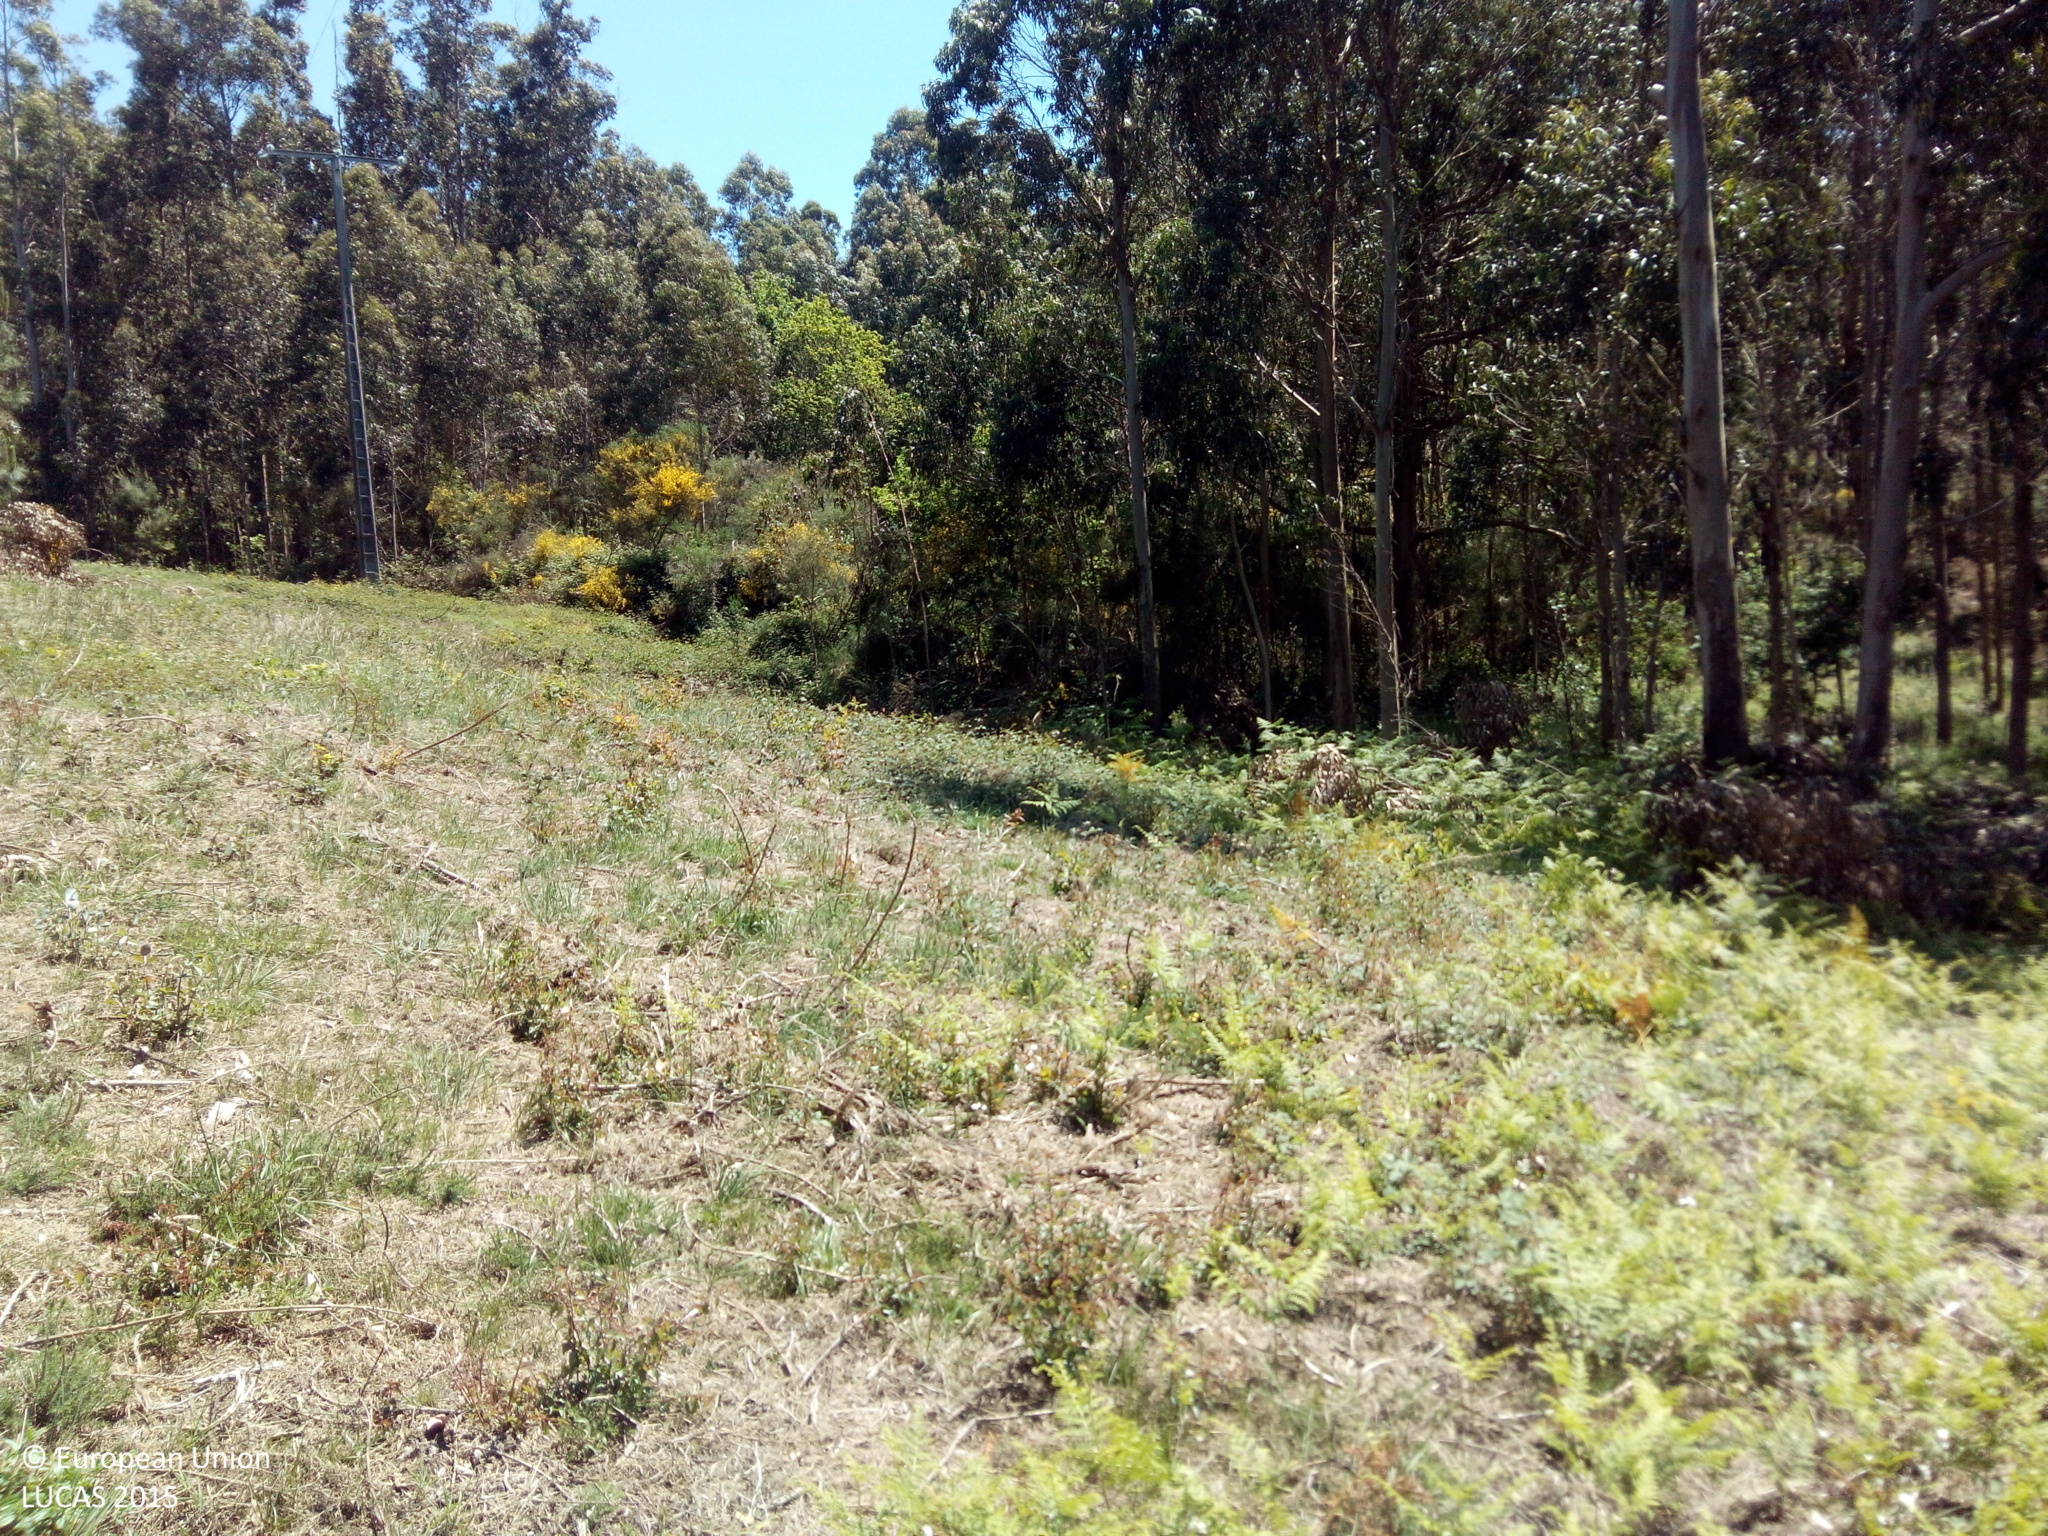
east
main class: Shrubland
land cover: Shrubland with sparse tree cover
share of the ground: > 75 %
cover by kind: shrubs 95 %, coniferous forest trees 5 %
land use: Forestry
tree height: > 5 m
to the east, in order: Shrubland with sparse tree cover; Electric lines; Broadleaved woodland; Artificial constructions; Pine dominated mixed woodland; Tracks; Pine dominated mixed woodland; Artificial constructions; Pine dominated mixed woodland; Dry stone walls; Pine dominated mixed woodland; Fences; Pine dominated mixed woodland; Tracks; Broadleaved woodland; Dry stone walls; Pine dominated mixed woodland
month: May
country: ES
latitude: 42.7038
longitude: -9.0033
